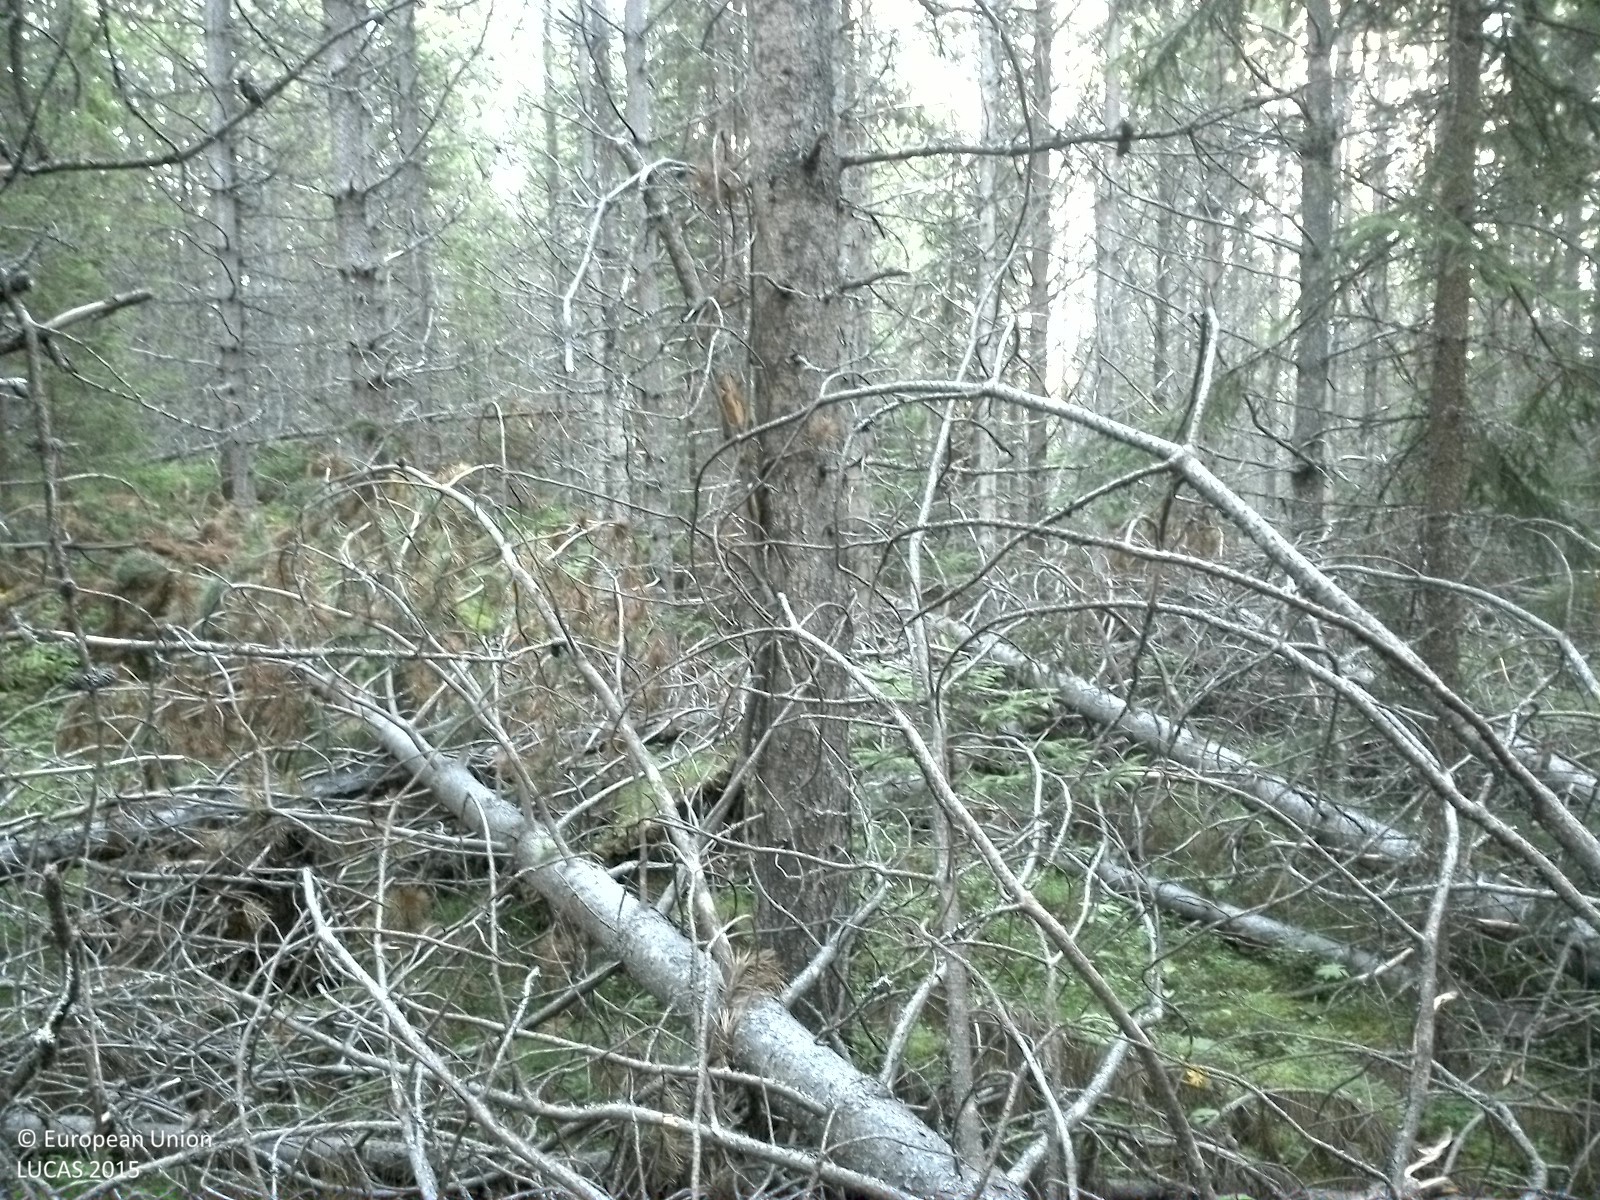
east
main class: Woodland
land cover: Pine dominated coniferous woodland
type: exotic forest
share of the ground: 50 - 75 %
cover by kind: coniferous forest trees 65 %, shrubs 25 %, lichens and mosses 10 %
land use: Forestry
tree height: > 5 m
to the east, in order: Pine dominated coniferous woodland
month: August
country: SE
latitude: 62.7420
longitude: 16.5343
